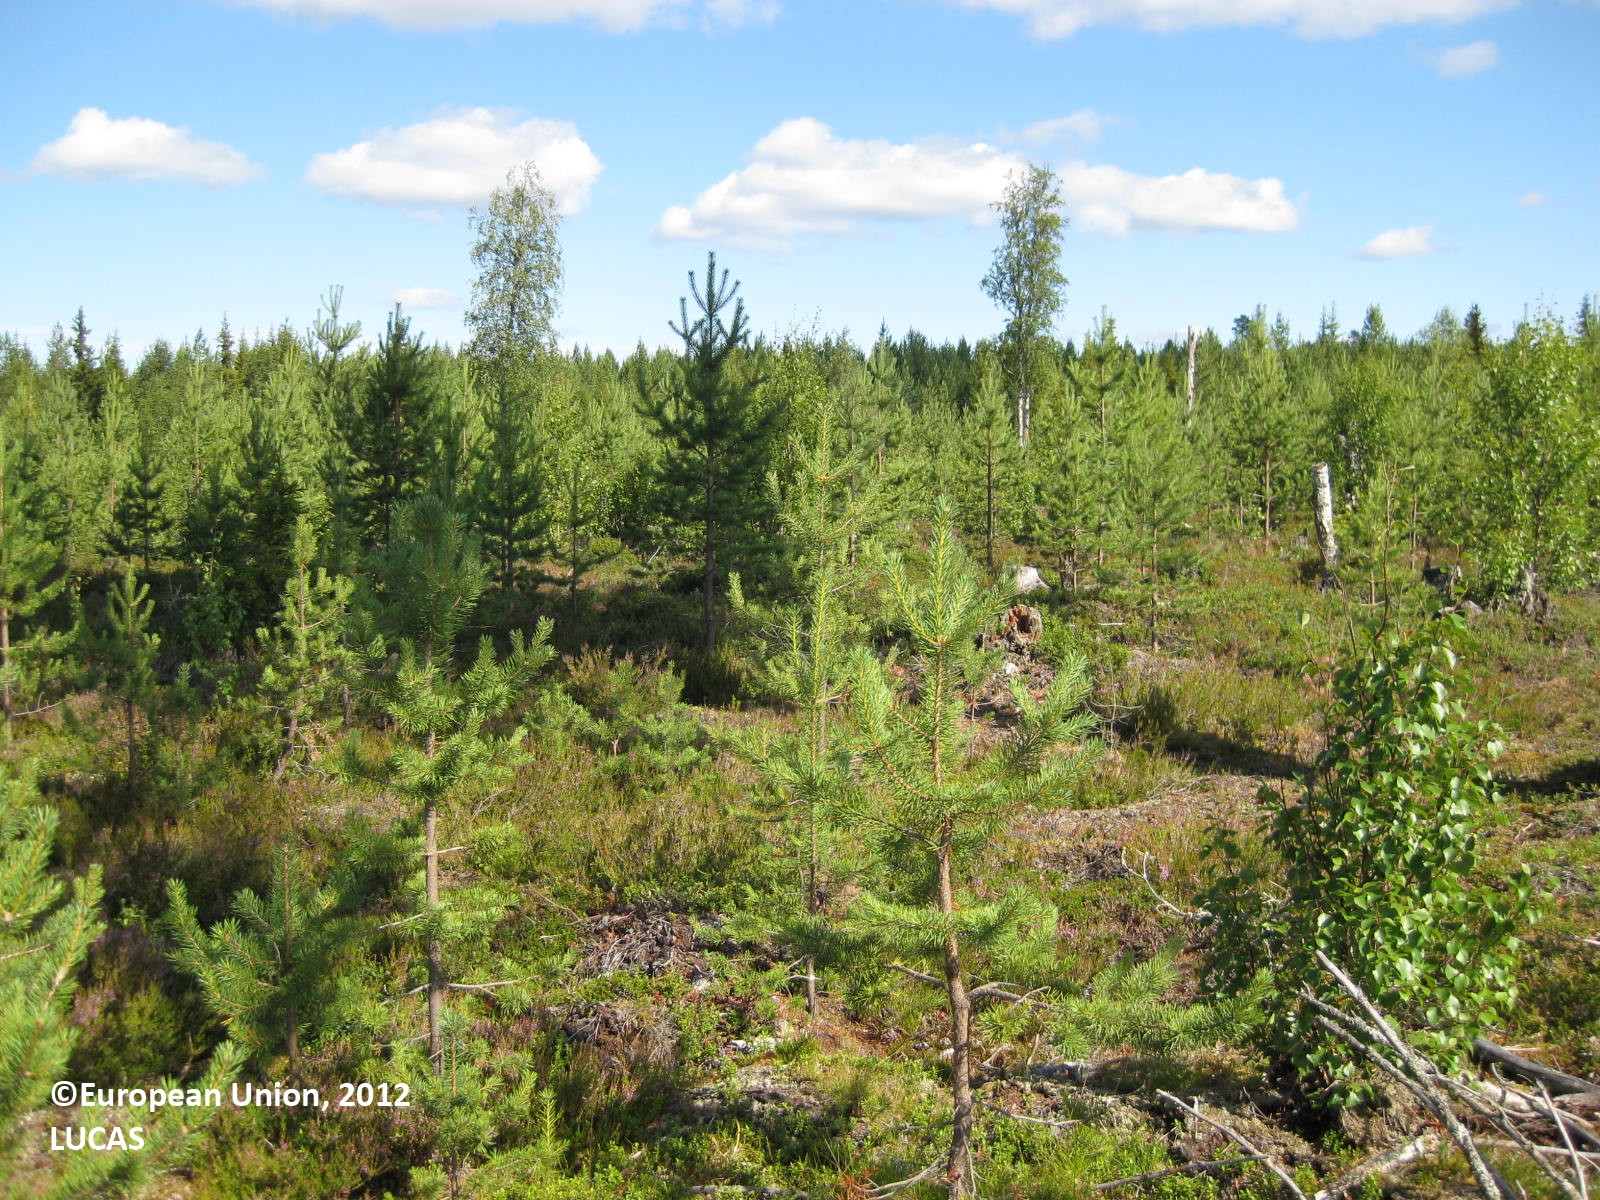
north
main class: Woodland
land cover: Pine dominated mixed woodland
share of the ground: 50 - 75 %
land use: Forestry
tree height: < 5 m
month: July
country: FI
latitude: 65.6735
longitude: 28.4539
